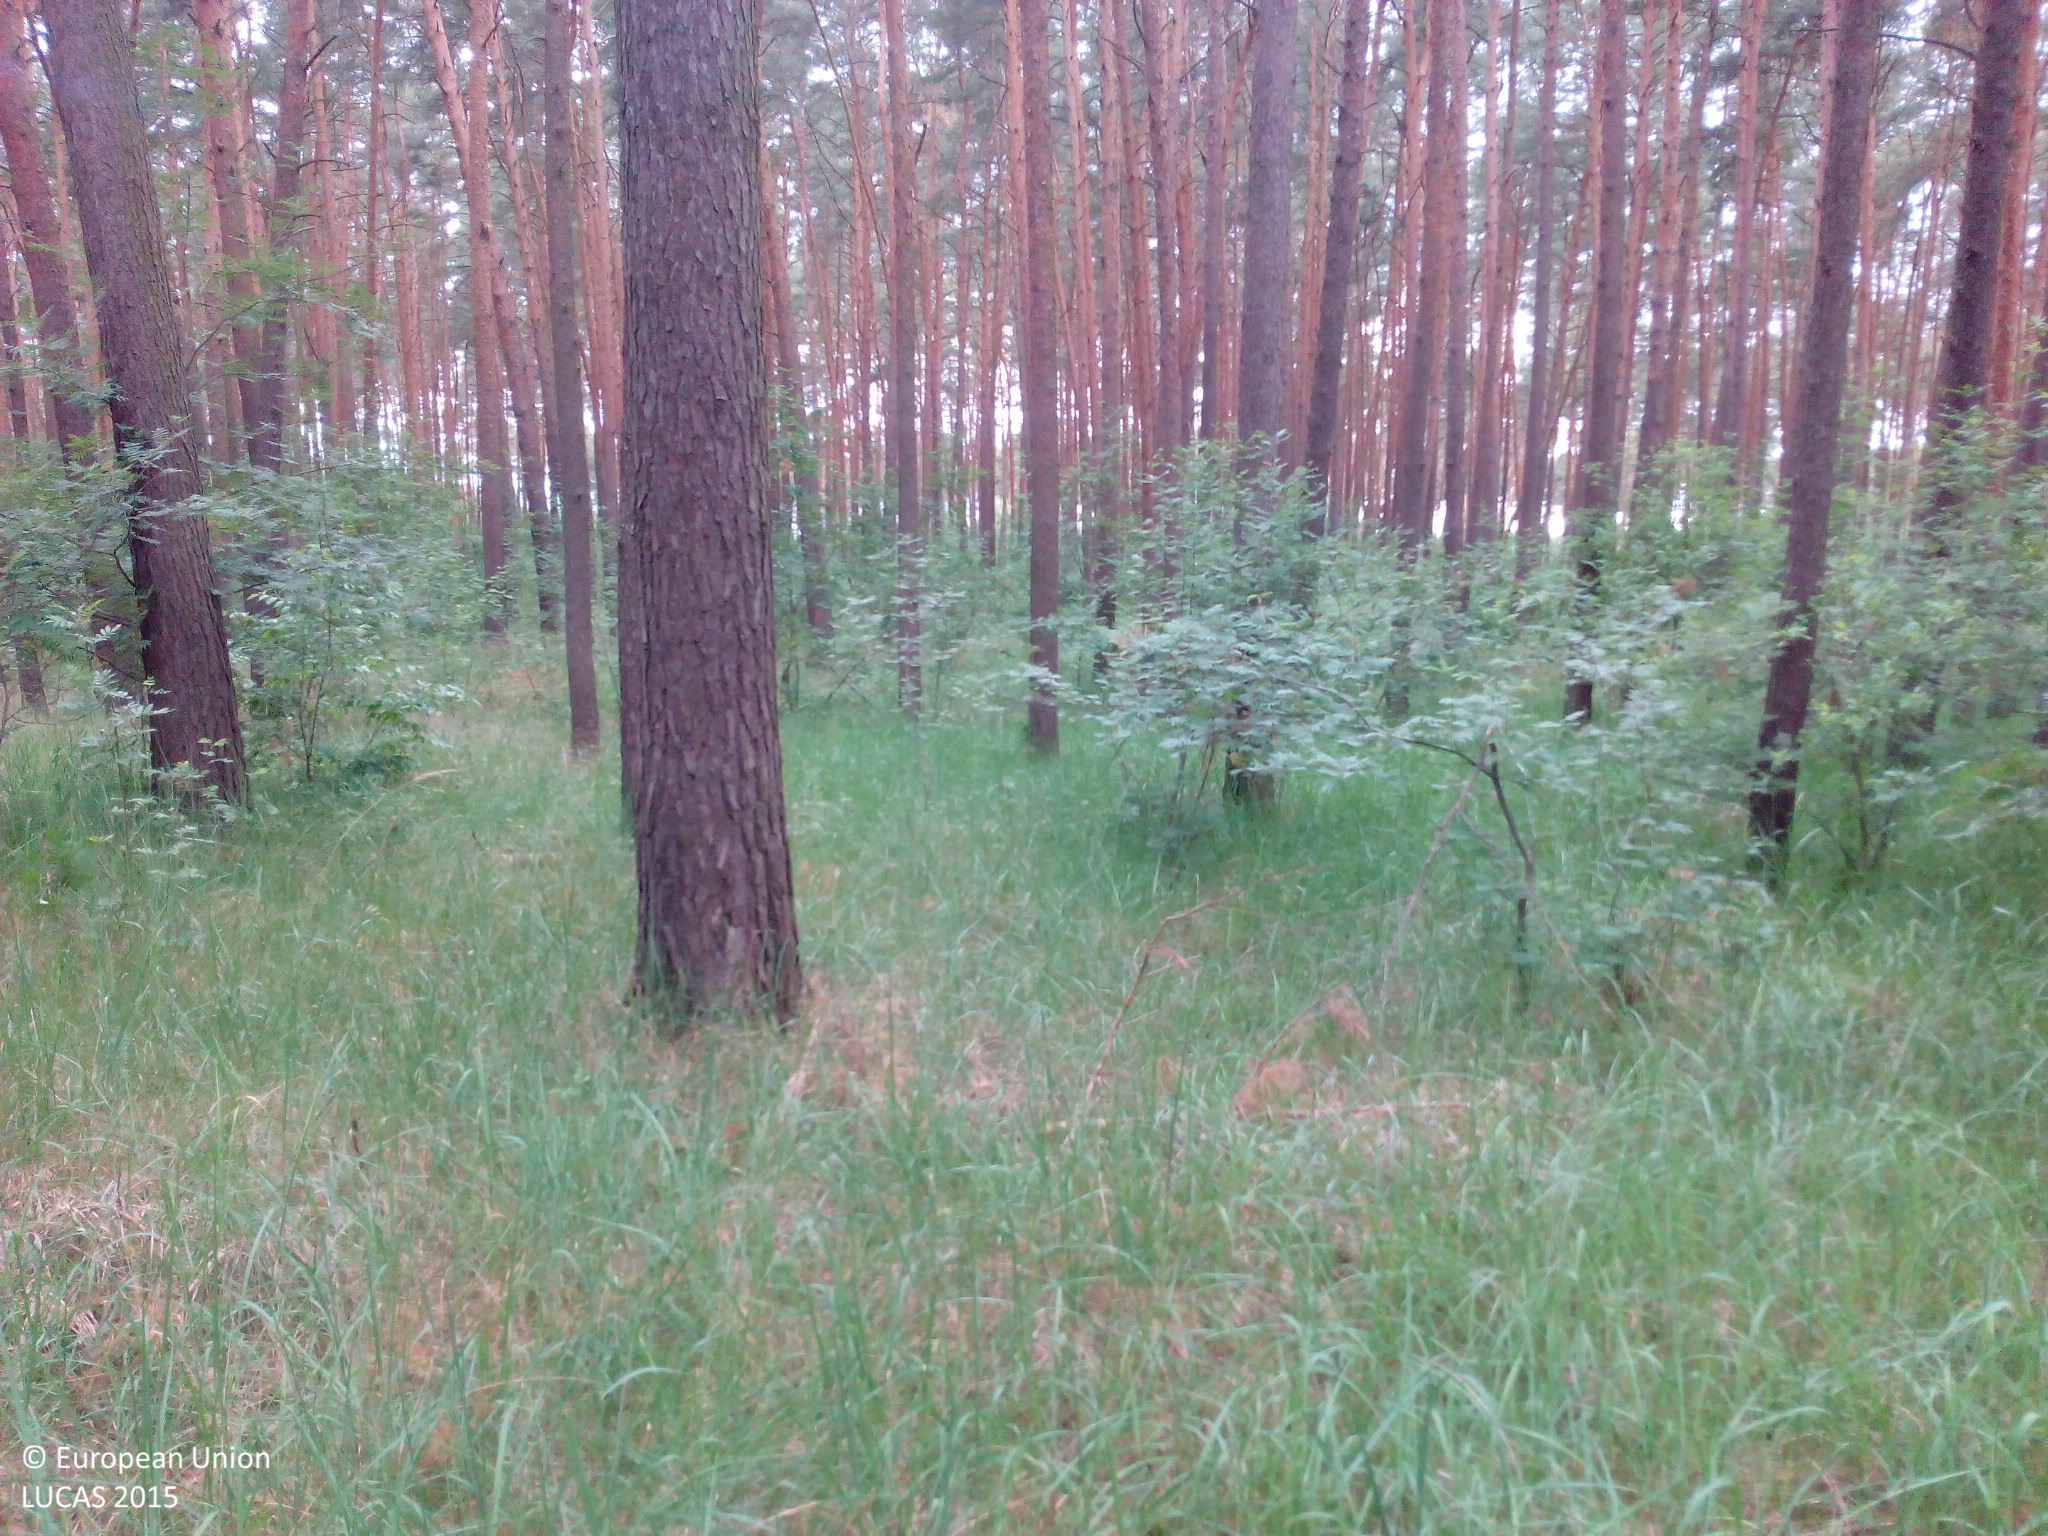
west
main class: Woodland
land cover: Pine dominated coniferous woodland
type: hemiboreal forest and nemoral coniferous forest and mixed broadleaved-coniferous forest
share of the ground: > 75 %
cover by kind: coniferous forest trees 80 %, herbaceous plants 15 %, lichens and mosses 5 %
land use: Forestry
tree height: > 5 m
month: June
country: DE
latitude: 52.4803
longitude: 12.3407
